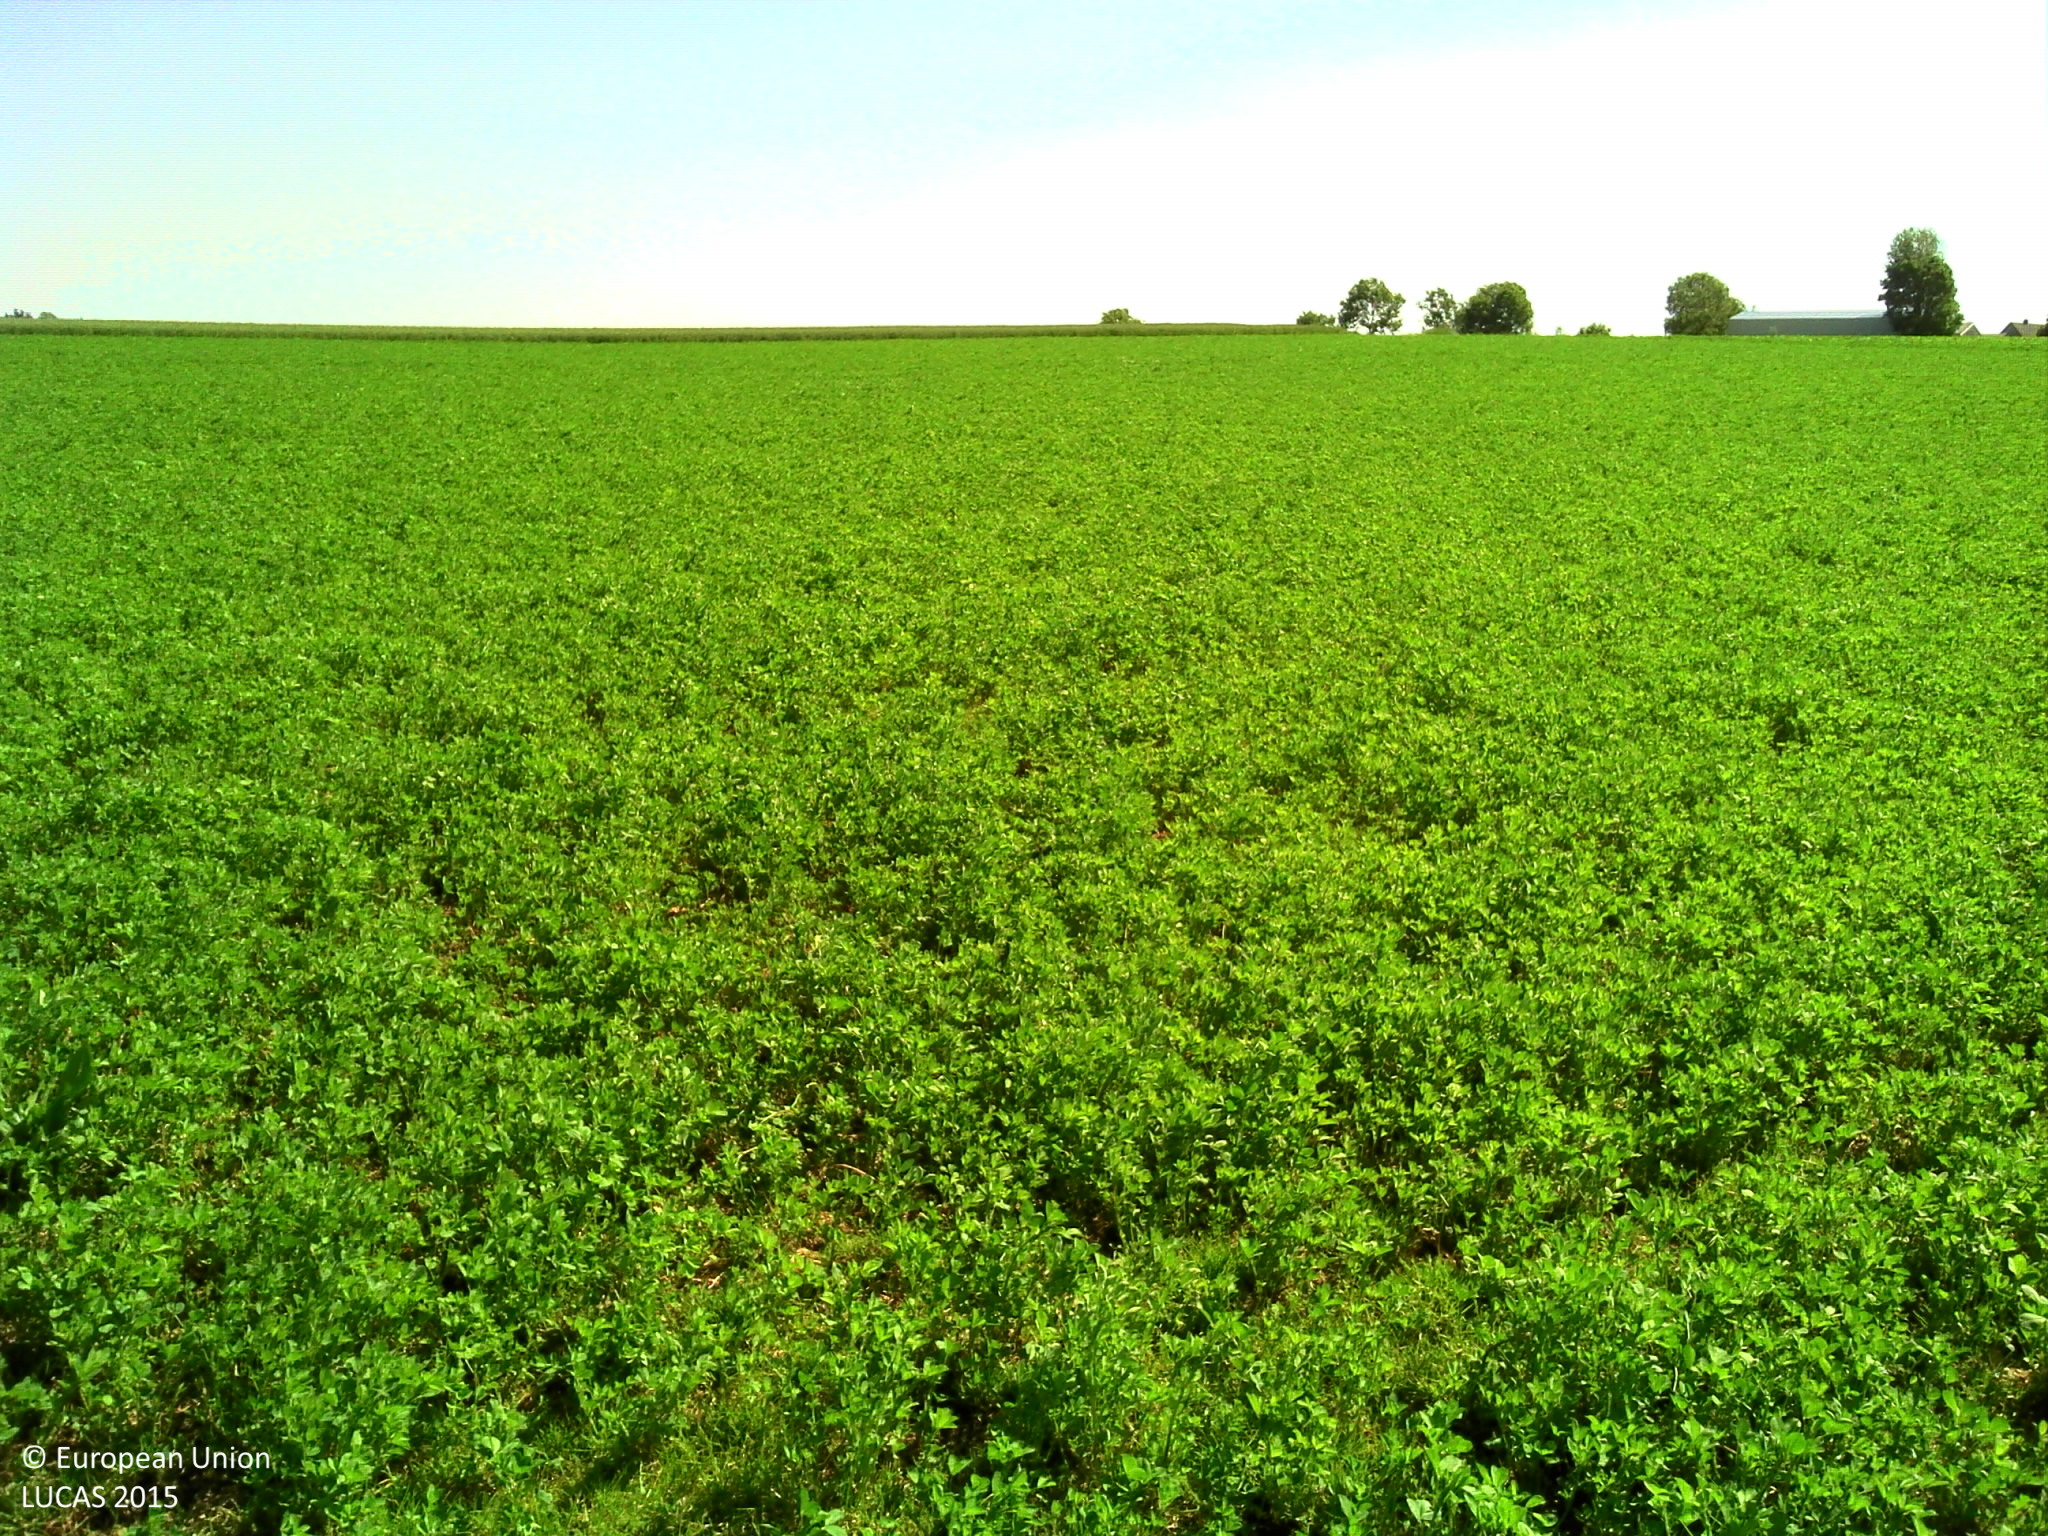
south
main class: Cropland
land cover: Lucerne
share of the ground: > 75 %
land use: Agriculture (excluding fallow land and kitchen gardens)
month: June
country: FR
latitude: 50.7424
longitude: 2.1200
